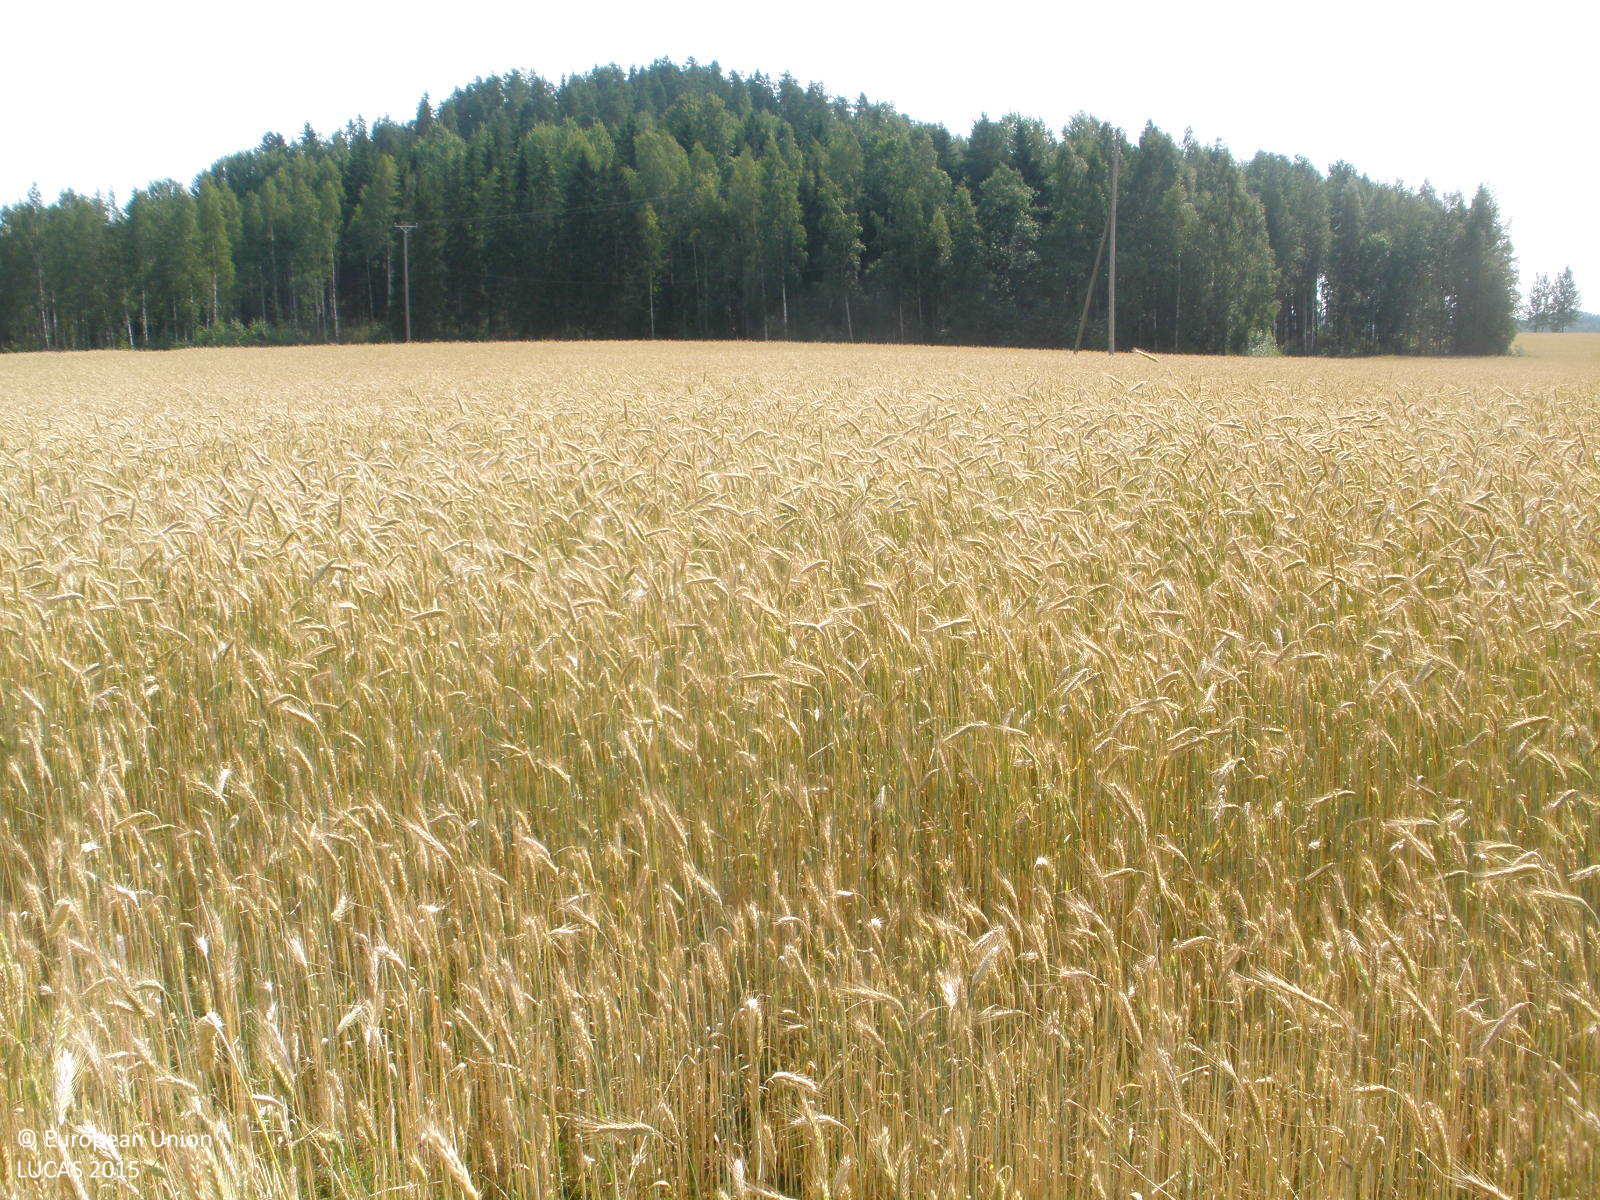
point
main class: Cropland
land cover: Common wheat
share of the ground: 50 - 75 %
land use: Agriculture (excluding fallow land and kitchen gardens)
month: August
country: FI
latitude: 60.8558
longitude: 24.5171
